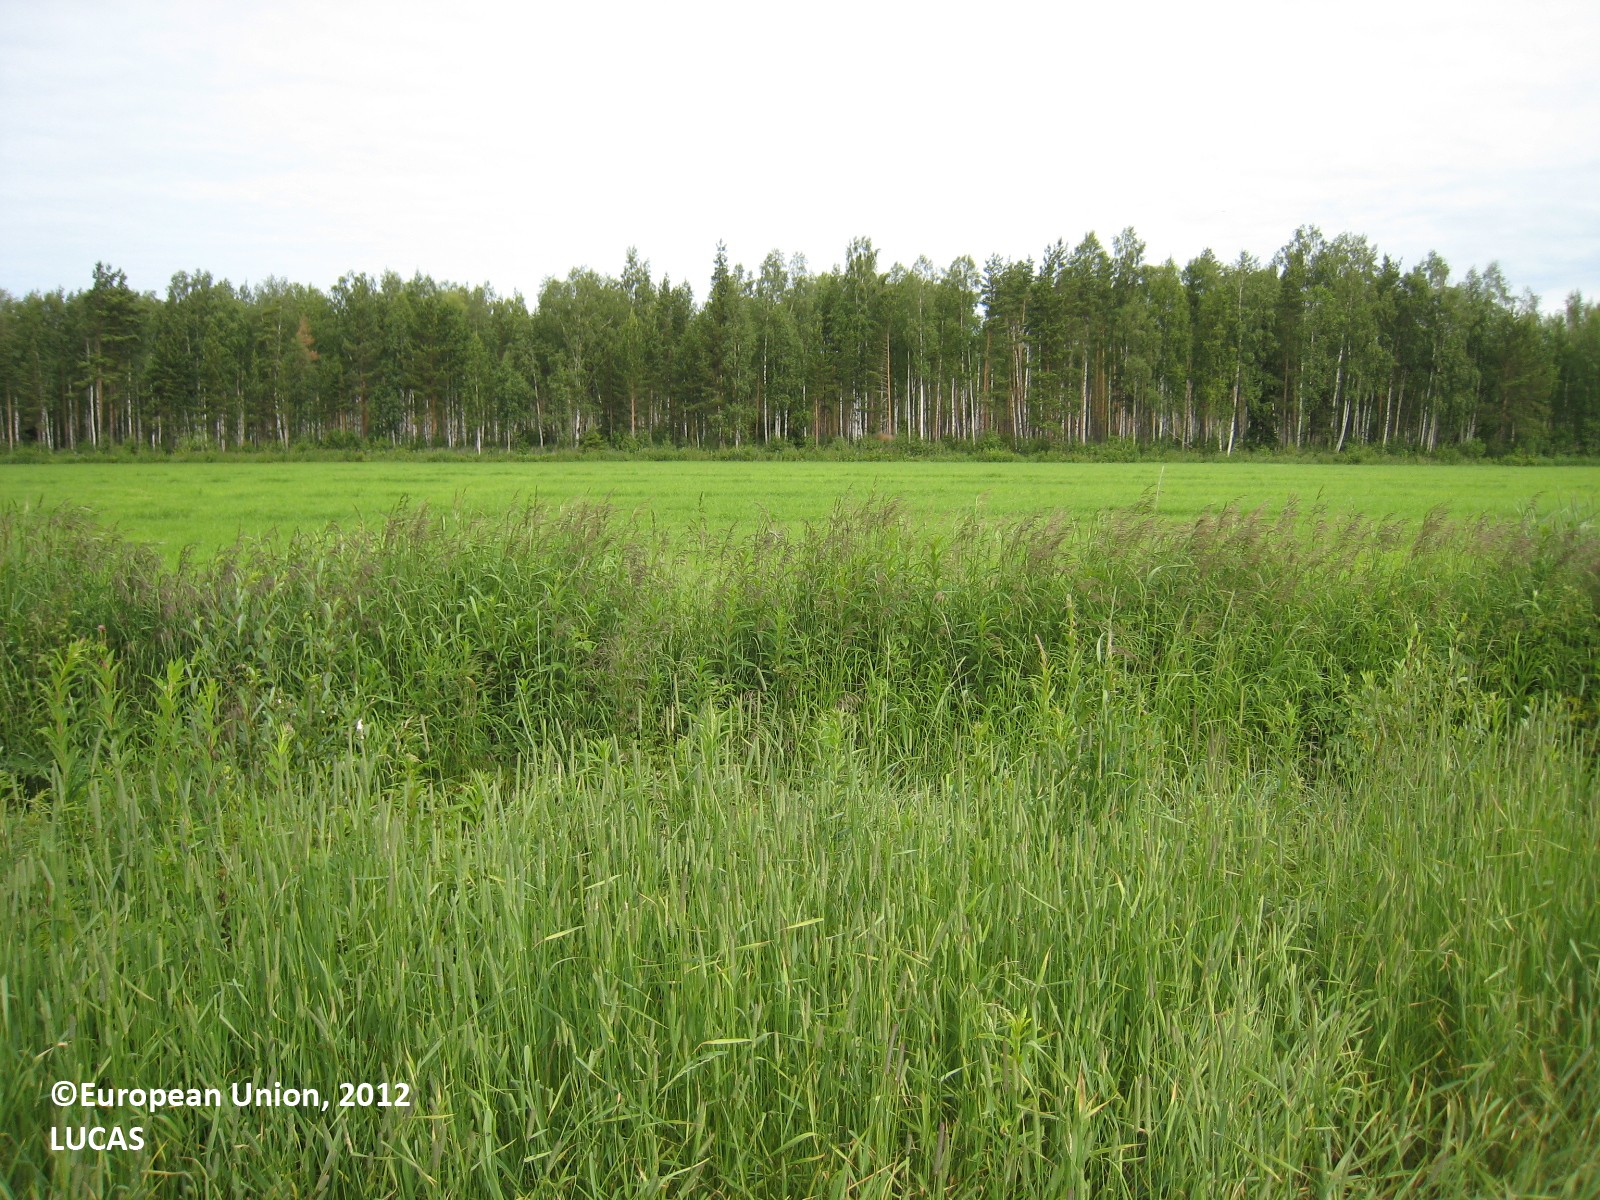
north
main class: Cropland
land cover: Temporary grasslands
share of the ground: > 75 %
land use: Agriculture (excluding fallow land and kitchen gardens)
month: June
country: FI
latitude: 62.3960
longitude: 26.3258
